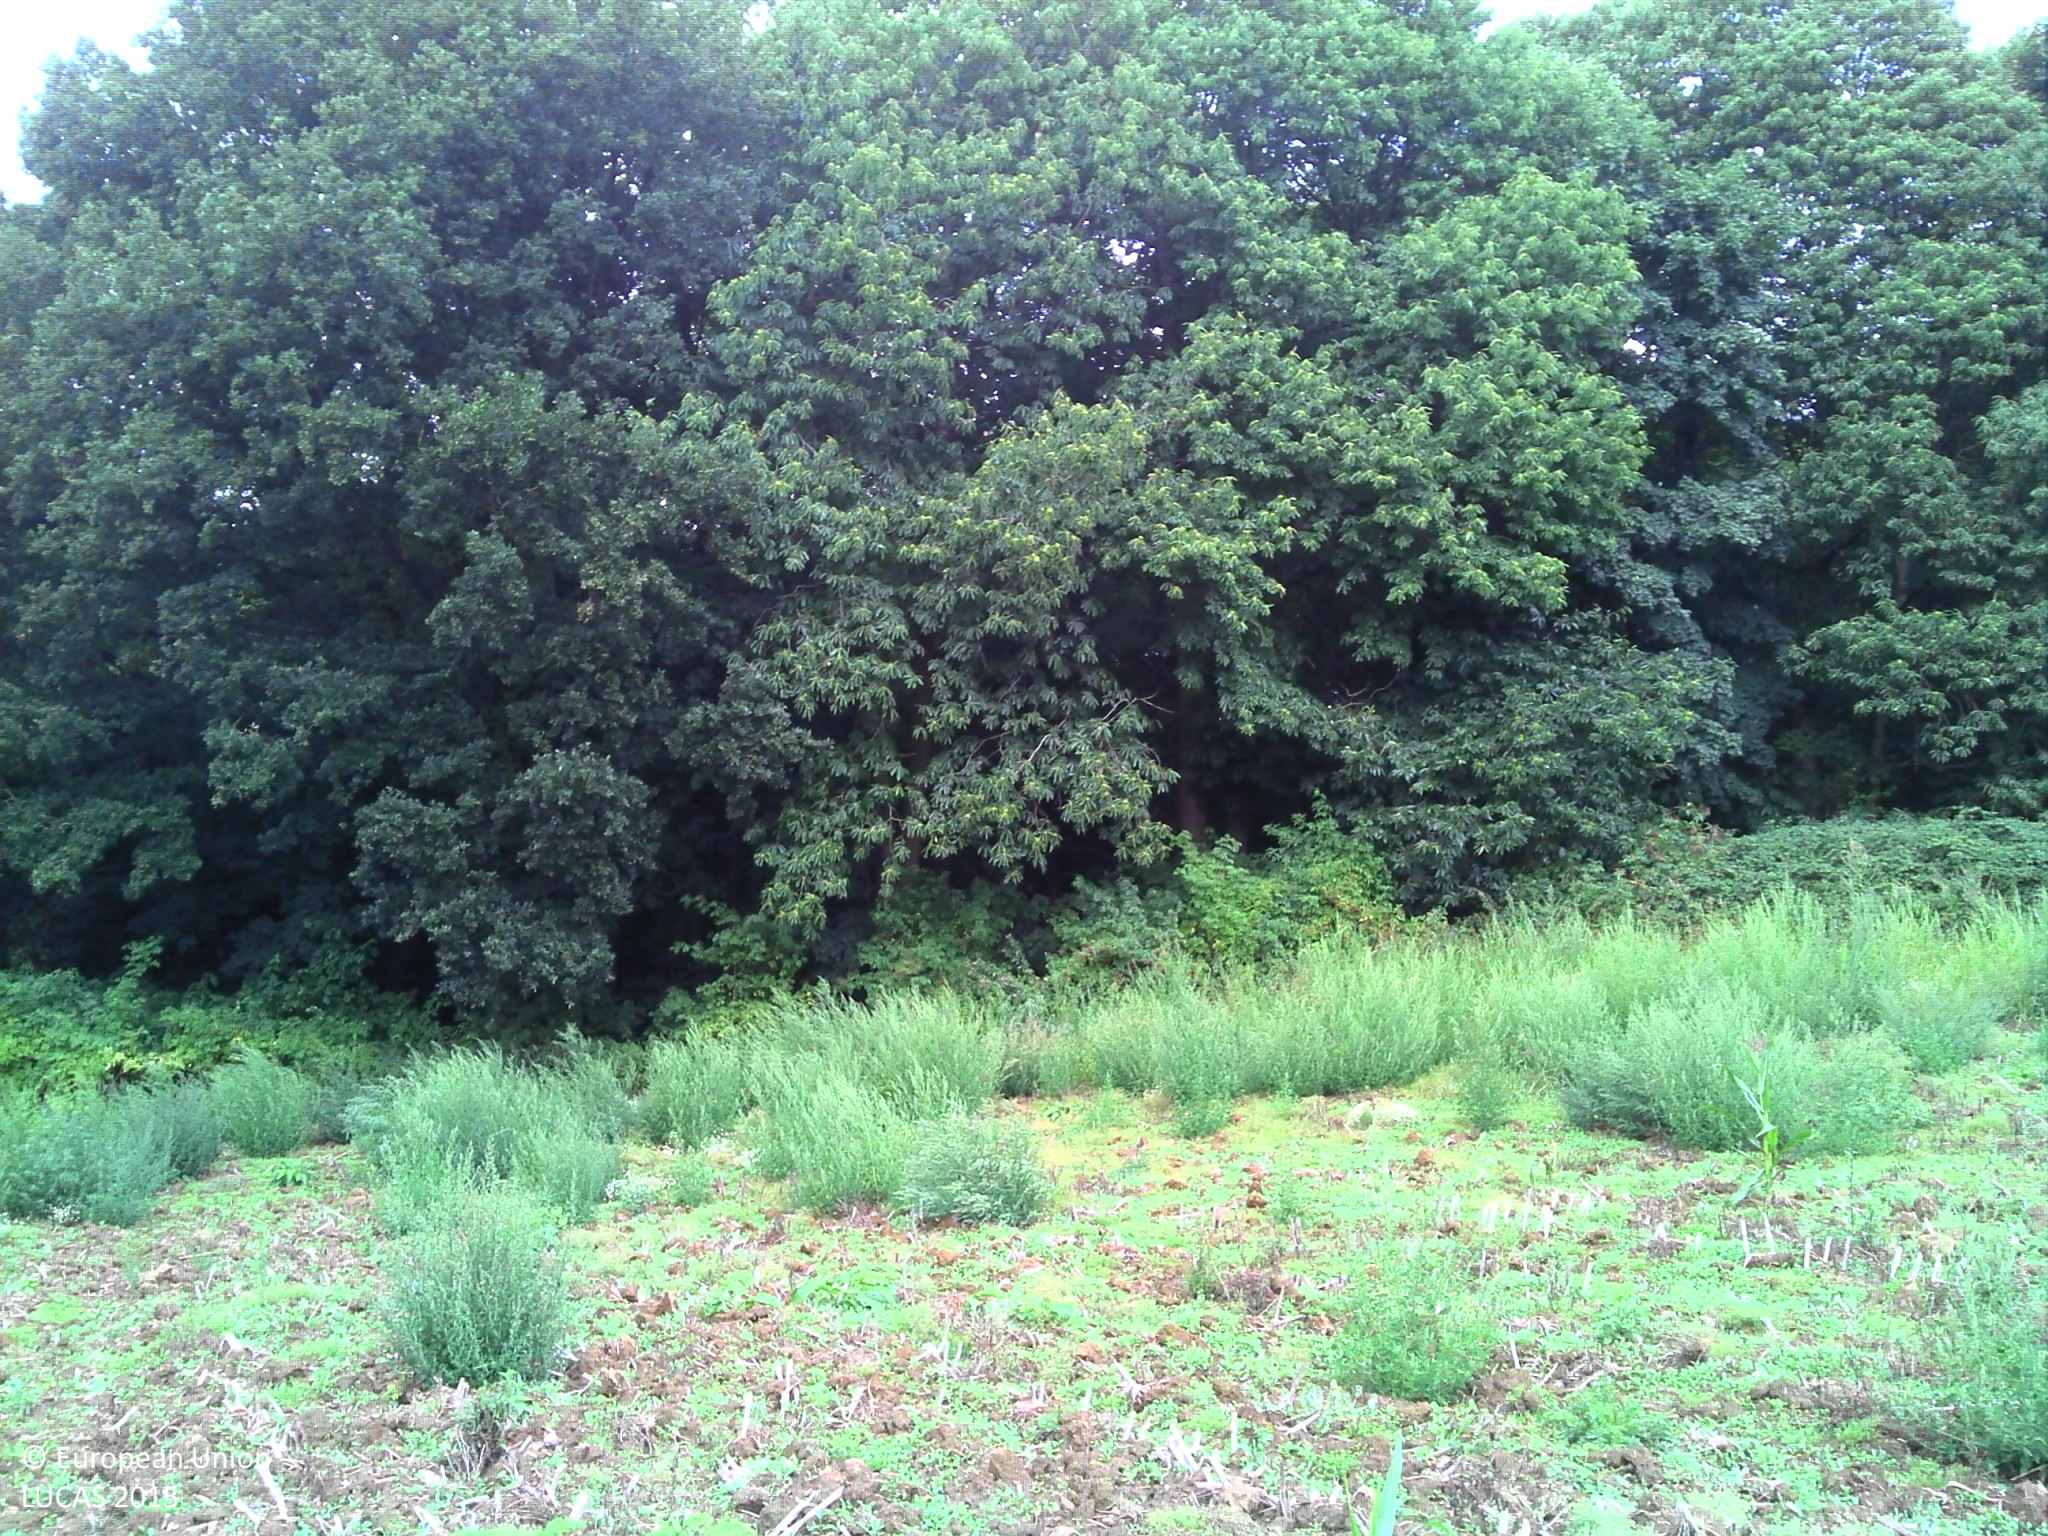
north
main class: Grassland
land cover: Spontaneously vegetated surfaces
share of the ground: > 75 %
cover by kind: herbaceous plants 50 %, unconsolidated bare surface 50 %
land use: Fallow land
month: August
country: BE
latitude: 50.7832
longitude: 2.7408
